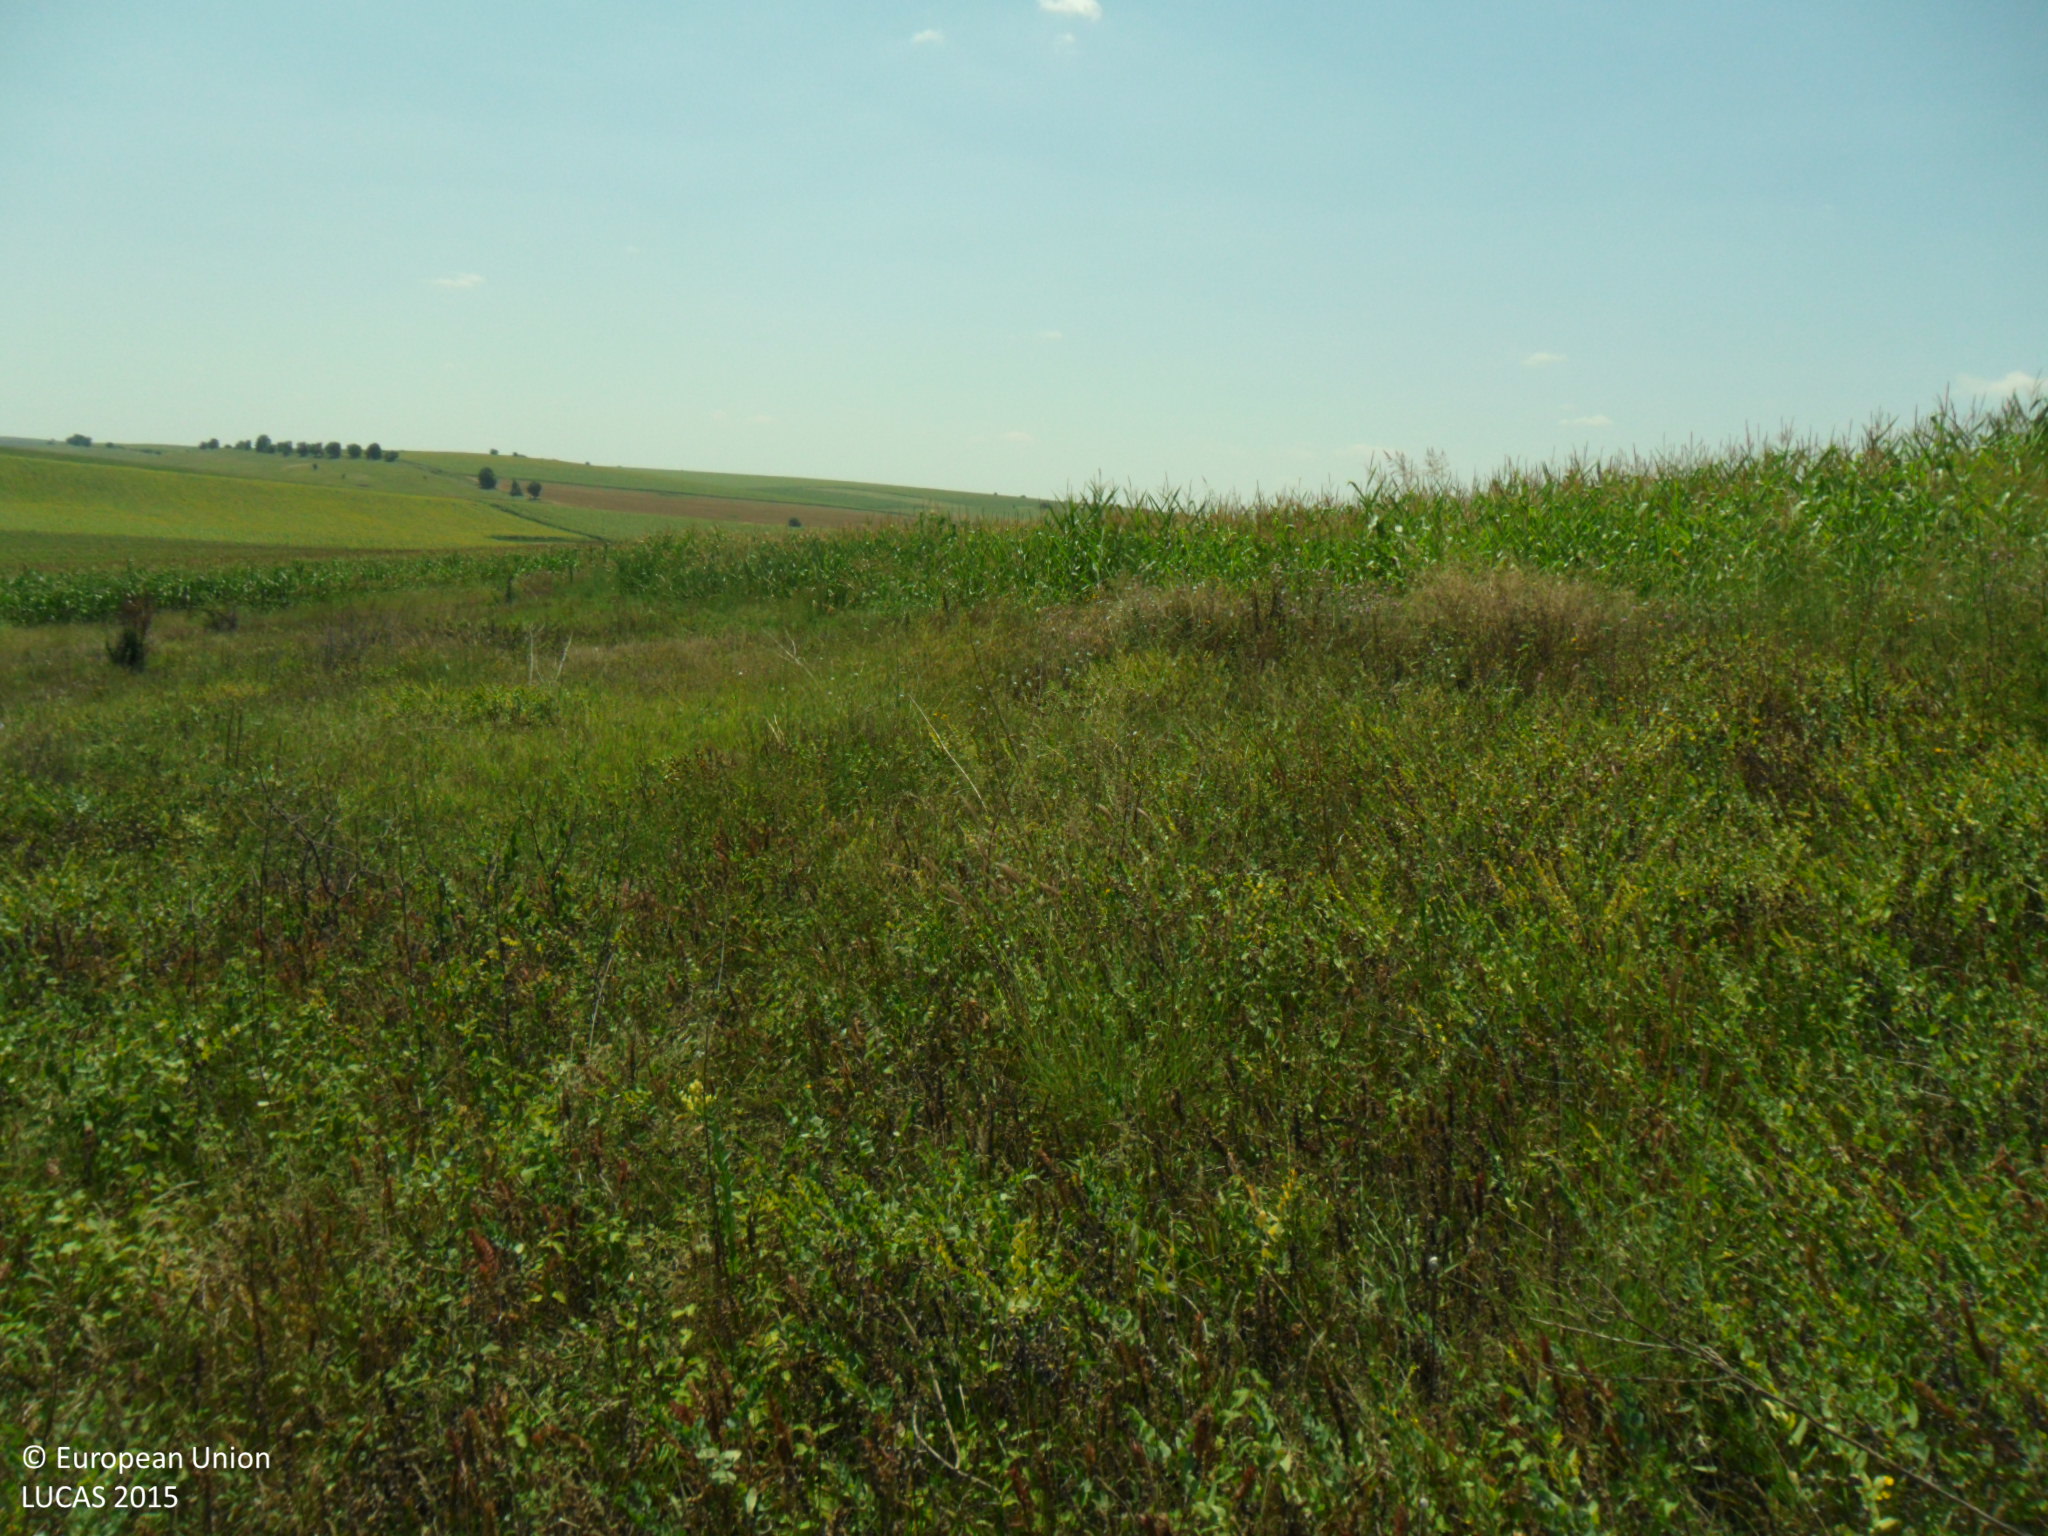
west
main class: Grassland
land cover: Grassland without tree/shrub cover
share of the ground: > 75 %
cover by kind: herbaceous plants 100 %
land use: Agriculture (excluding fallow land and kitchen gardens)
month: July
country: BG
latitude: 43.9174
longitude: 26.5111
